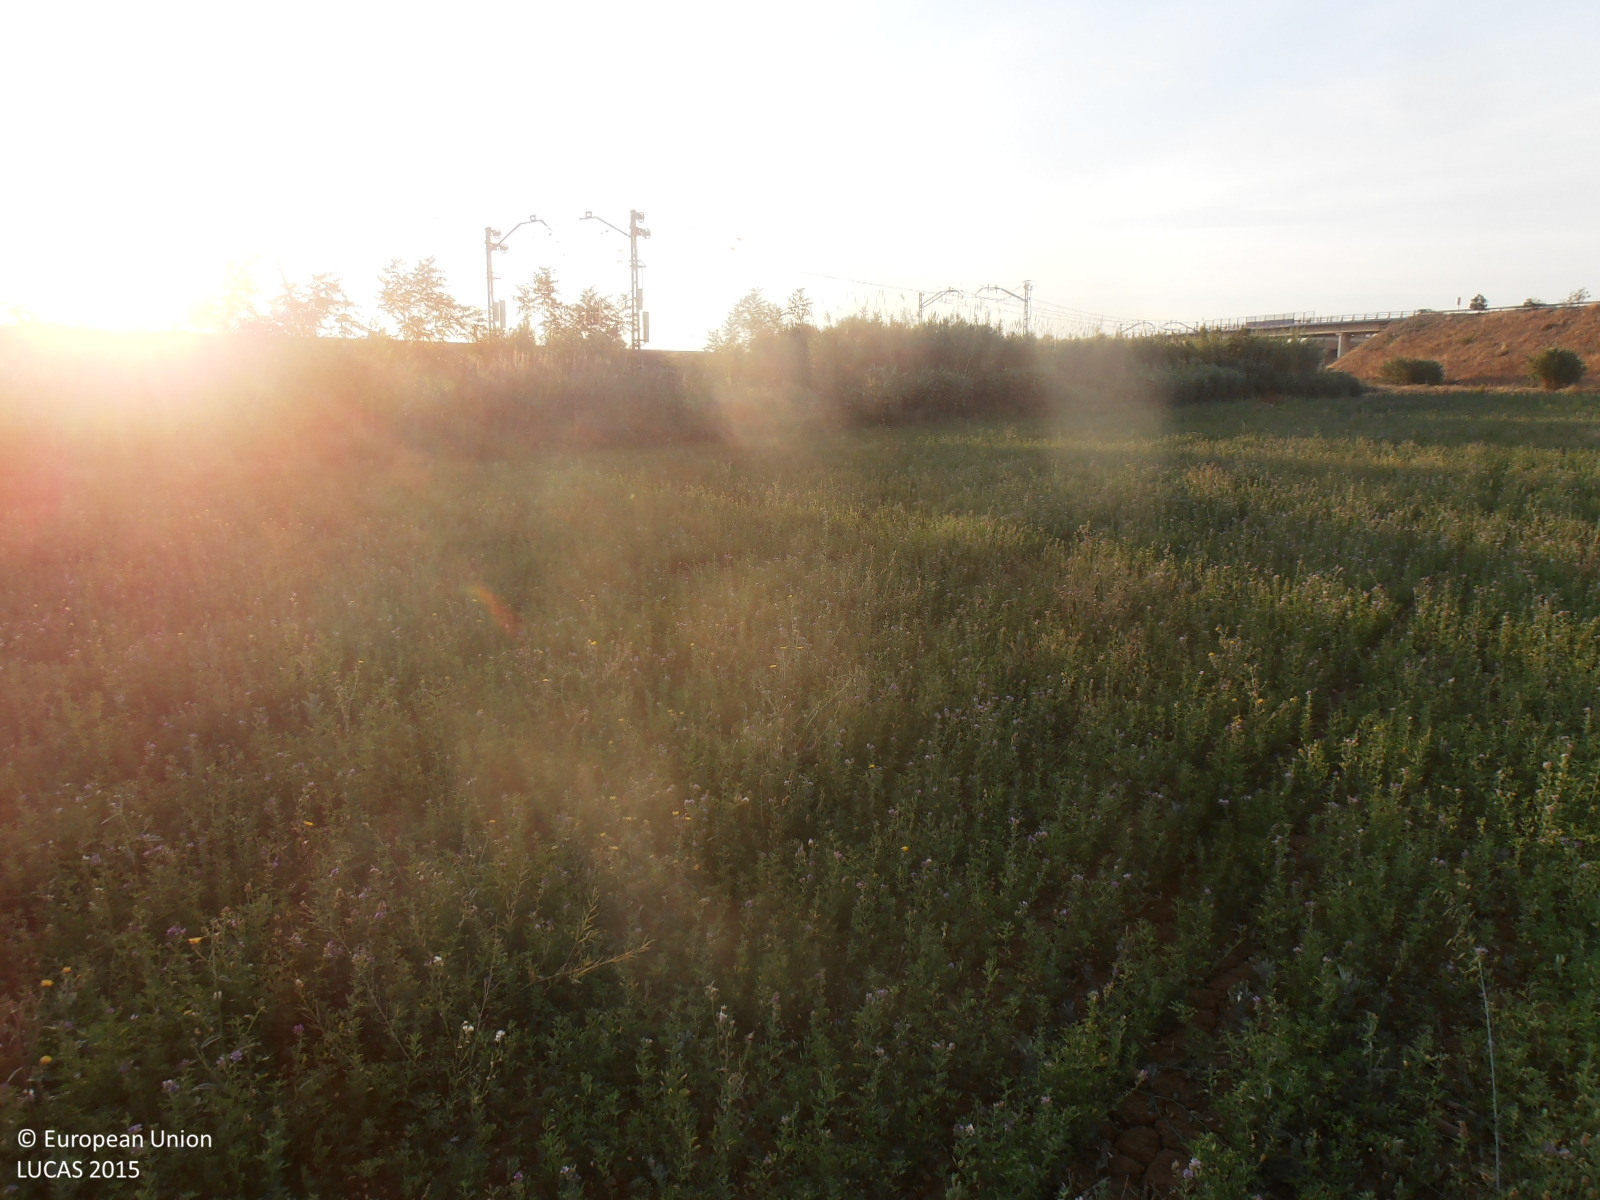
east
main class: Cropland
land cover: Lucerne
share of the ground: > 75 %
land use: Agriculture (excluding fallow land and kitchen gardens)
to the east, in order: Lucerne; Shrubland without tree cover; Fences; Electric lines; Railways; Electric lines; Railways; Fences; Shrubland without tree cover; Other fruit trees and berries; Managed hedges; Tracks; Fences; Shrubland without tree cover; Paved roads, cycling and walking lanes; Grassland without tree/shrub cover; Paved roads, cycling and walking lanes; Shrubland without tree cover
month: June
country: ES
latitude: 41.6922
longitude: -0.9686
